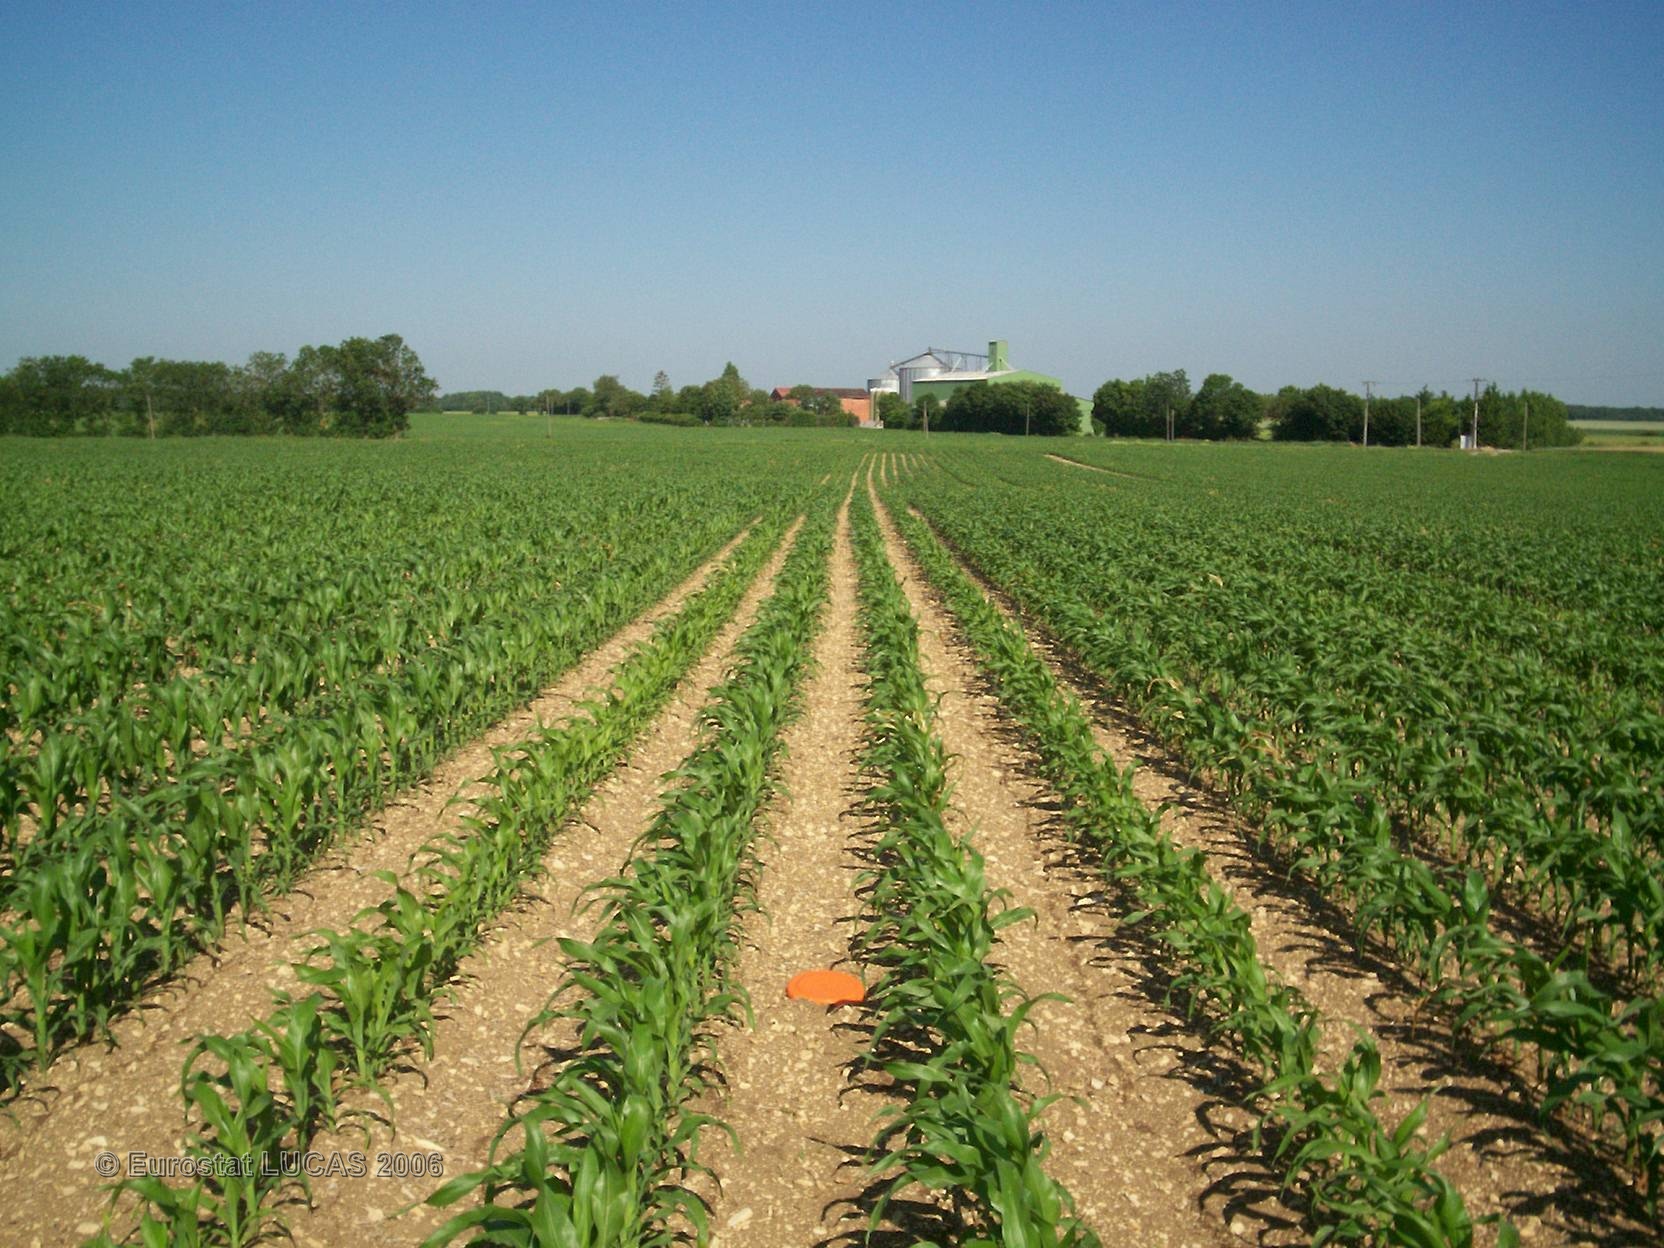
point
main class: Cropland
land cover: Maize
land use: Agriculture (excluding fallow land and kitchen gardens)
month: June
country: FR
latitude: 46.1926
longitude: -0.7172
